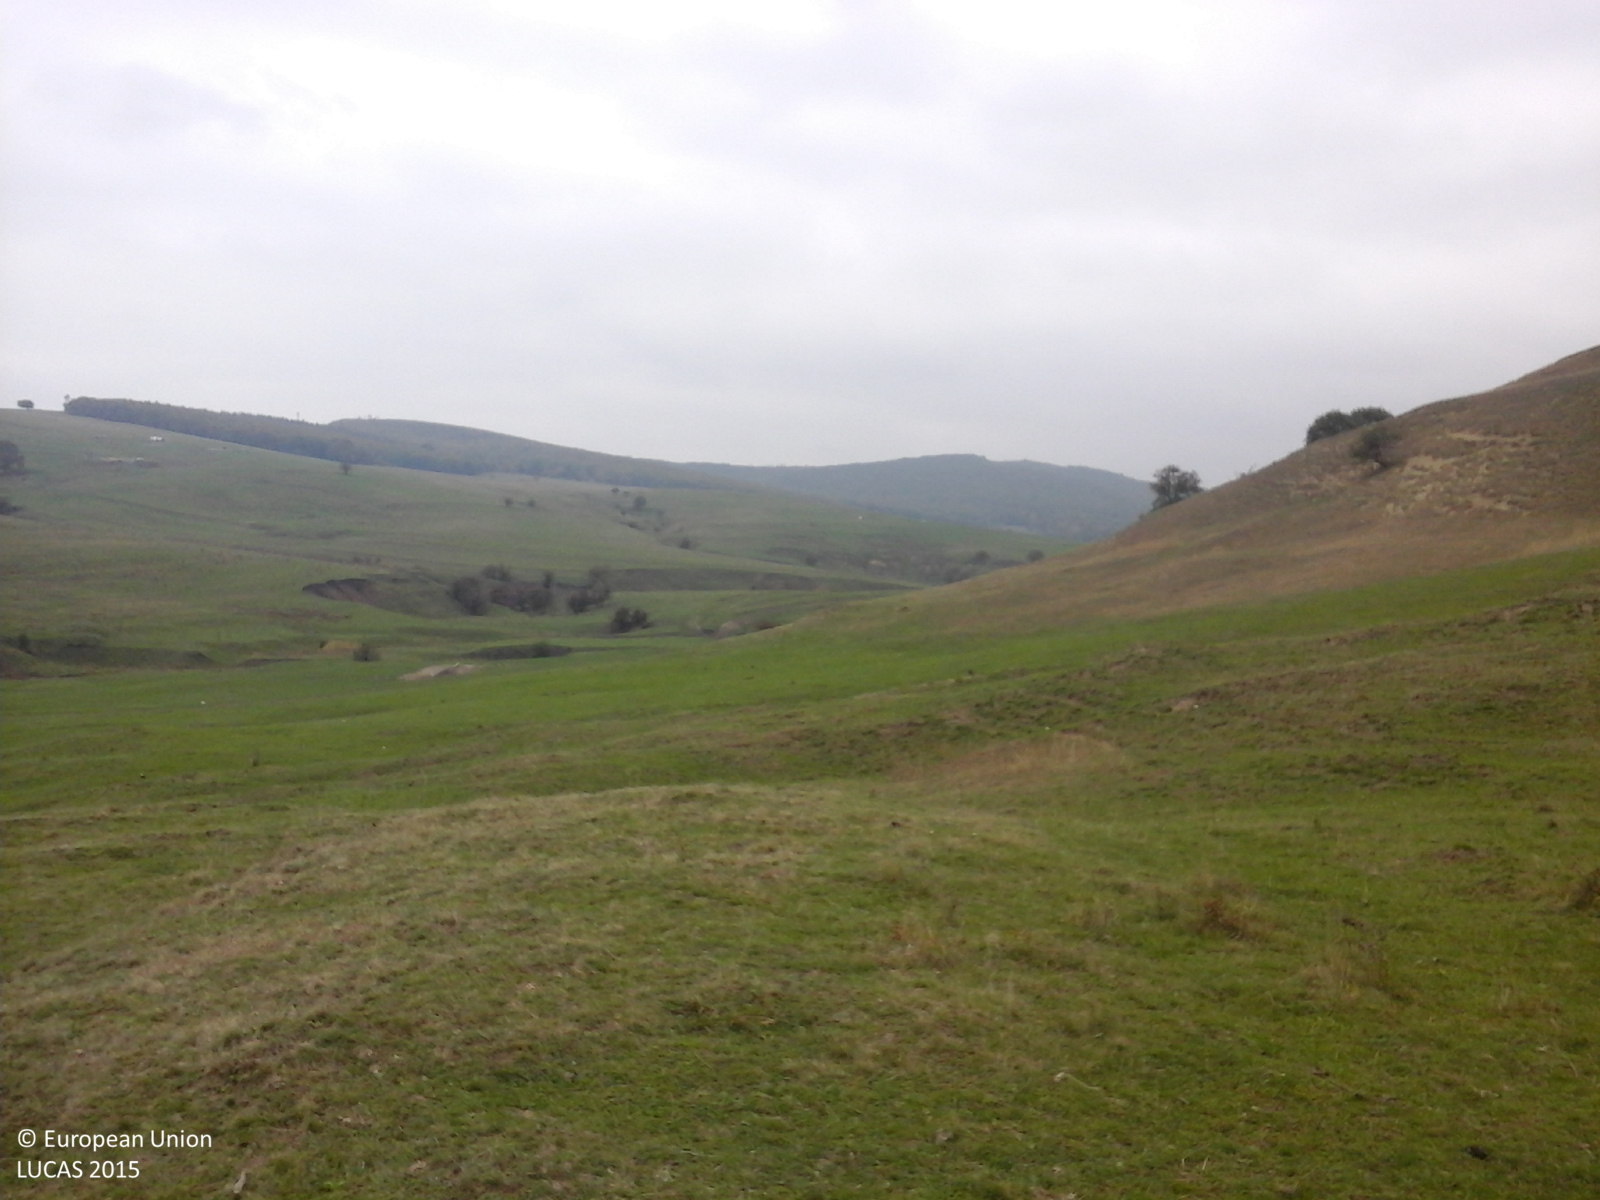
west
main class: Grassland
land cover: Grassland without tree/shrub cover
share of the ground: > 75 %
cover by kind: herbaceous plants 100 %
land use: Agriculture (excluding fallow land and kitchen gardens)
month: October
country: RO
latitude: 46.0196
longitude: 25.1189
